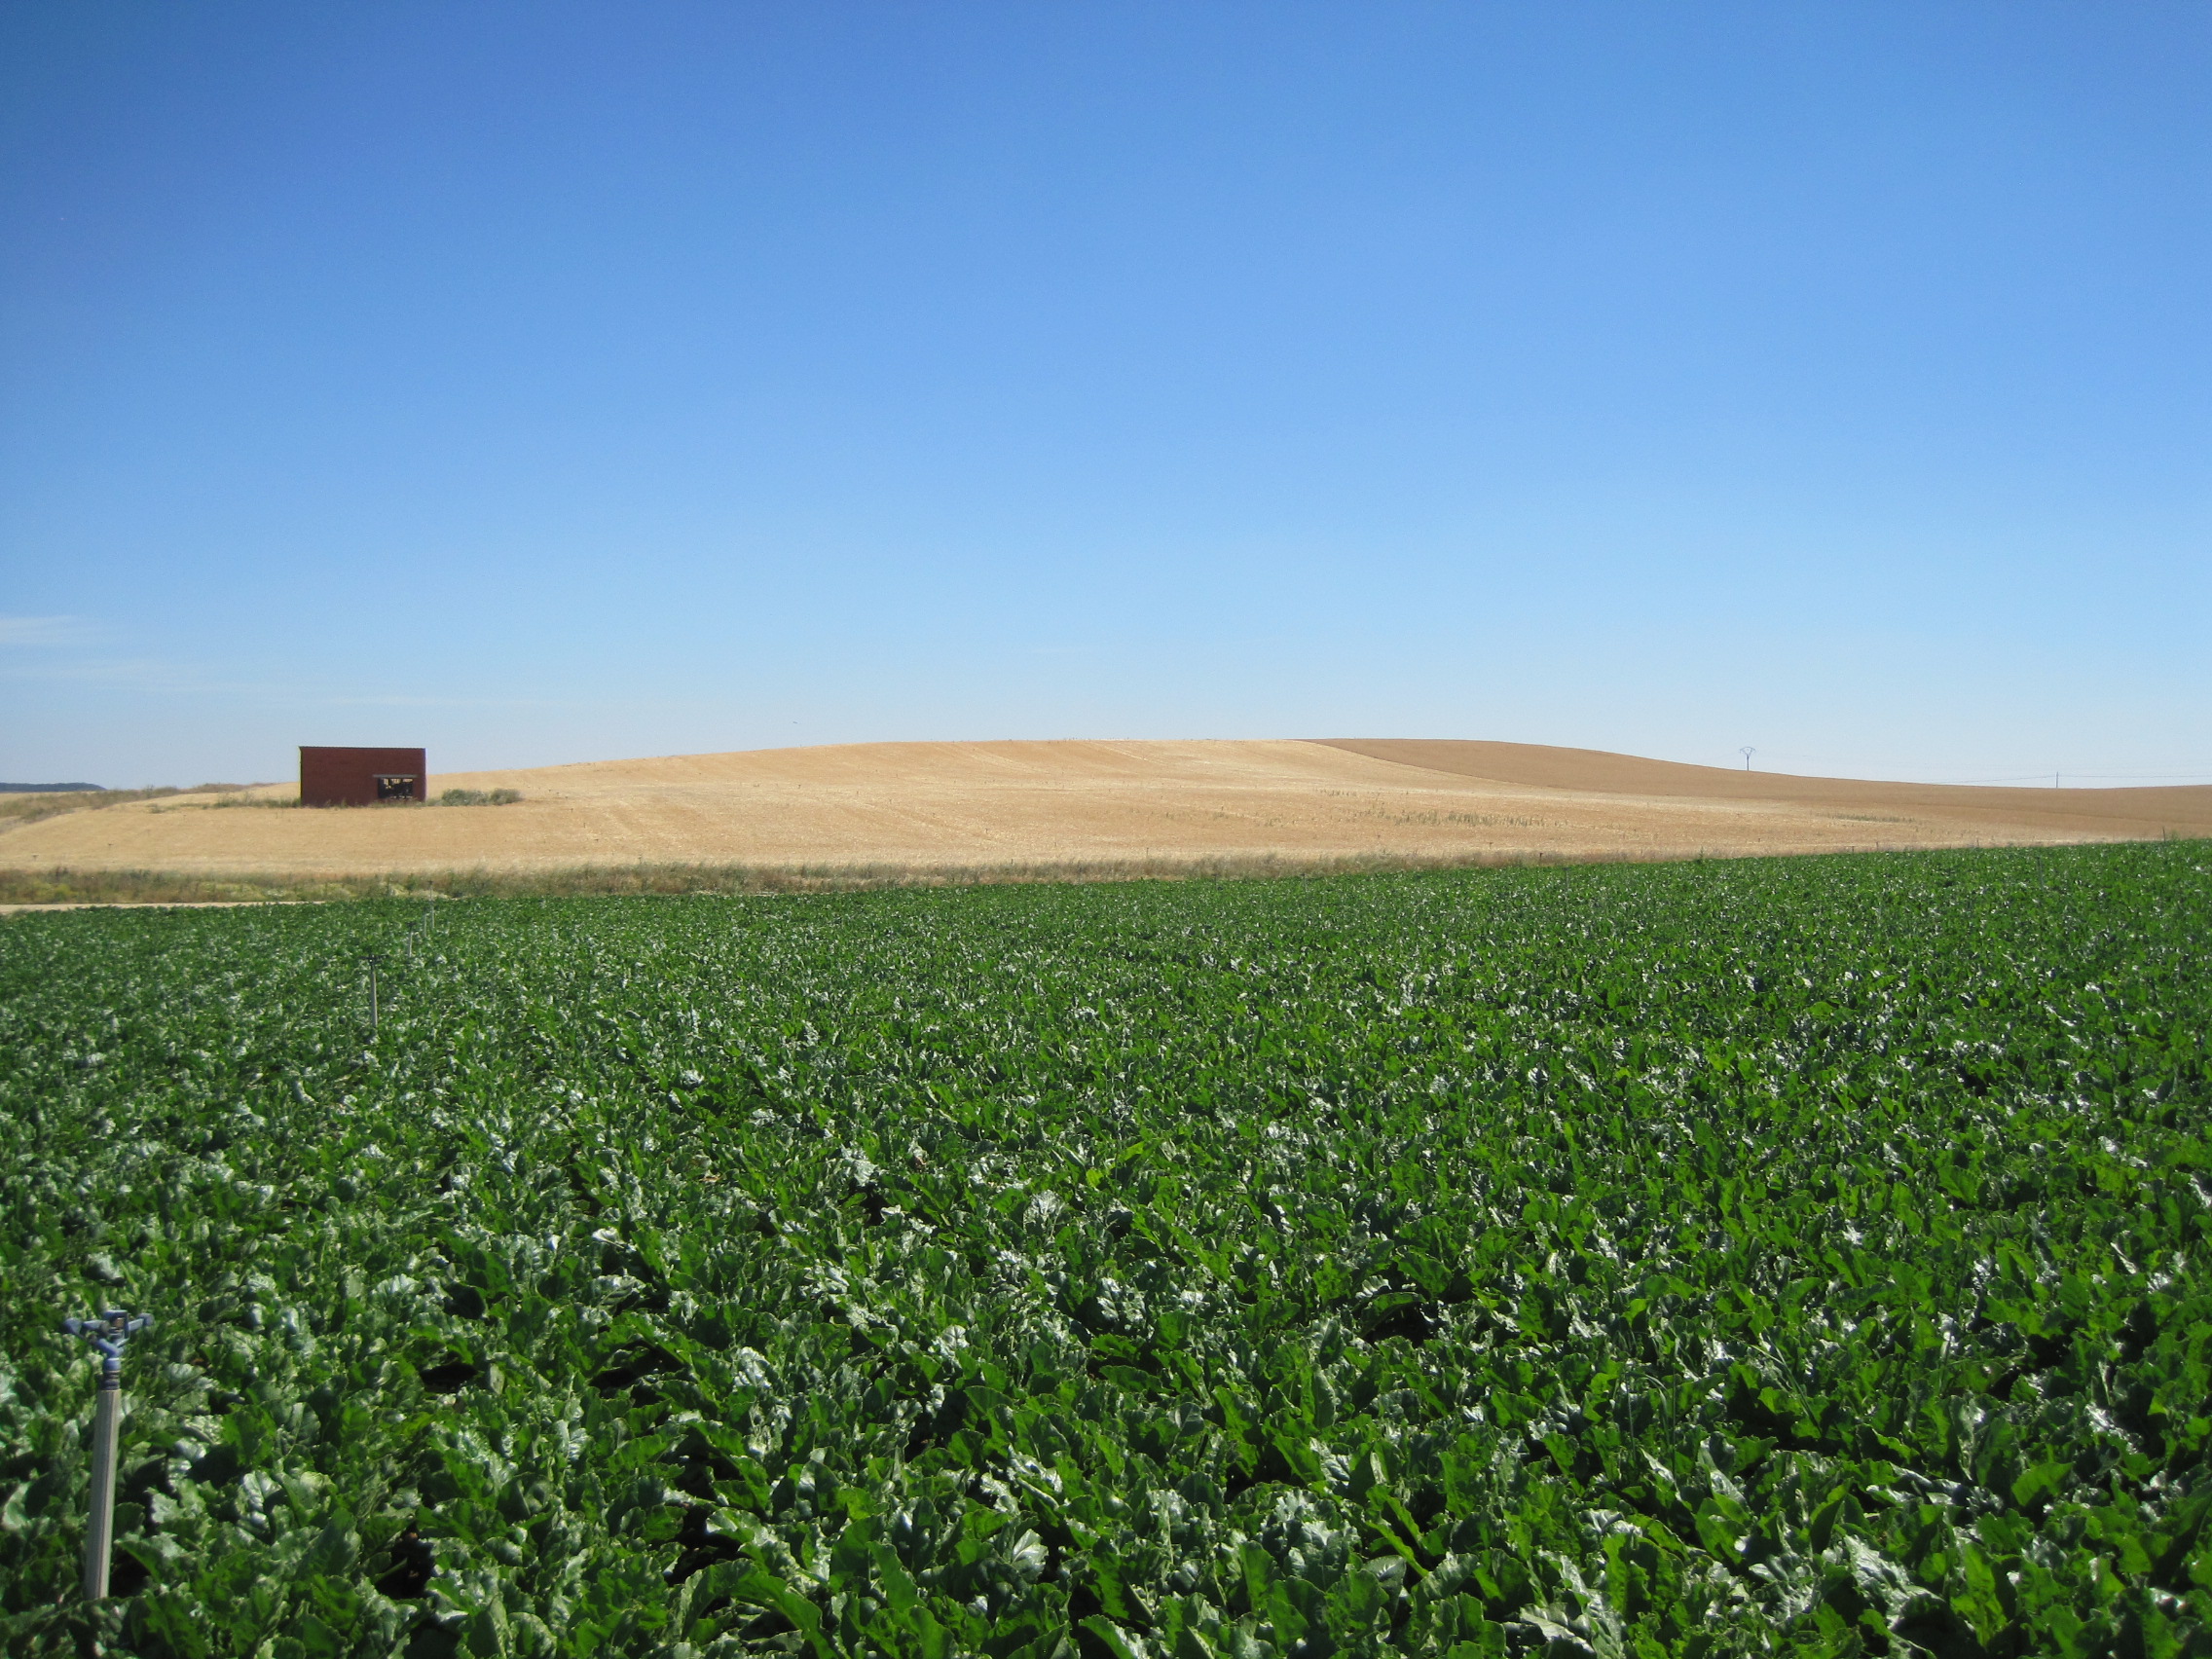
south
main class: Cropland
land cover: Sugar beet
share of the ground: > 75 %
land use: Agriculture (excluding fallow land and kitchen gardens)
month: June
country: ES
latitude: 41.6468
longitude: -5.1939
